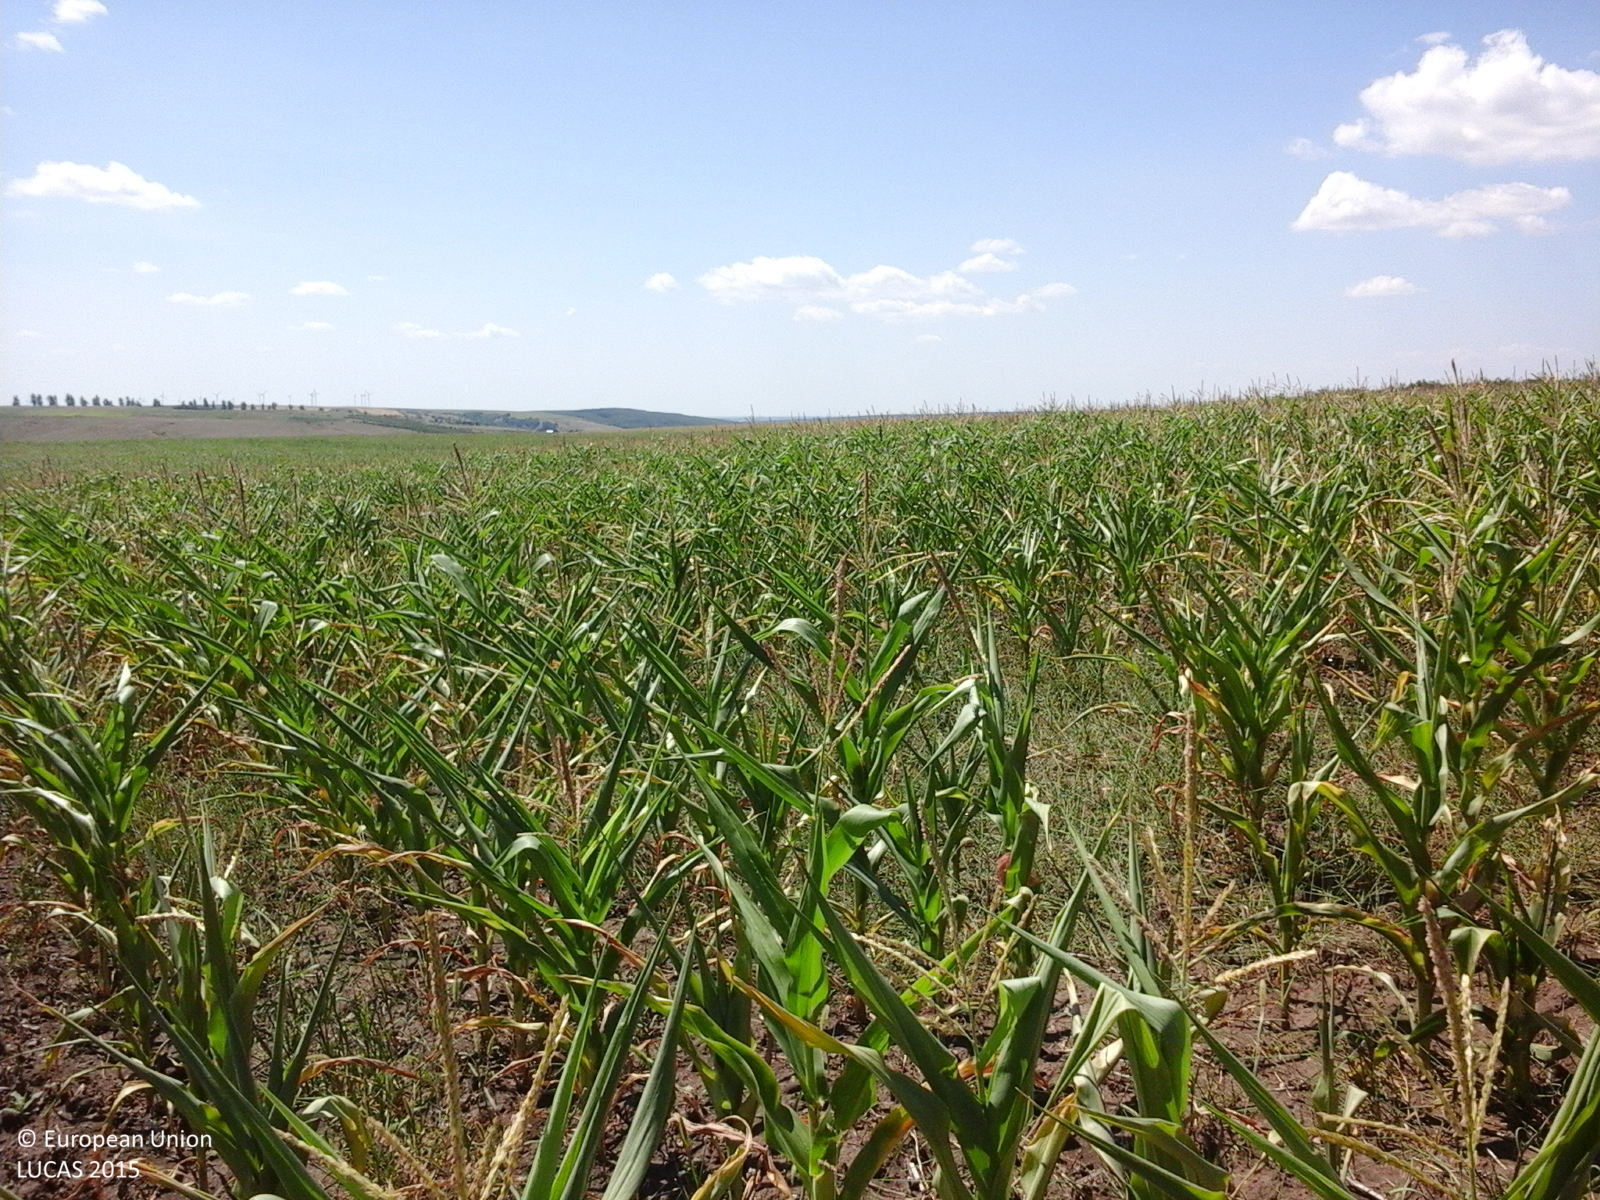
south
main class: Cropland
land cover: Maize
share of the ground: > 75 %
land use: Agriculture (excluding fallow land and kitchen gardens)
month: July
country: RO
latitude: 45.9433
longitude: 27.7204
